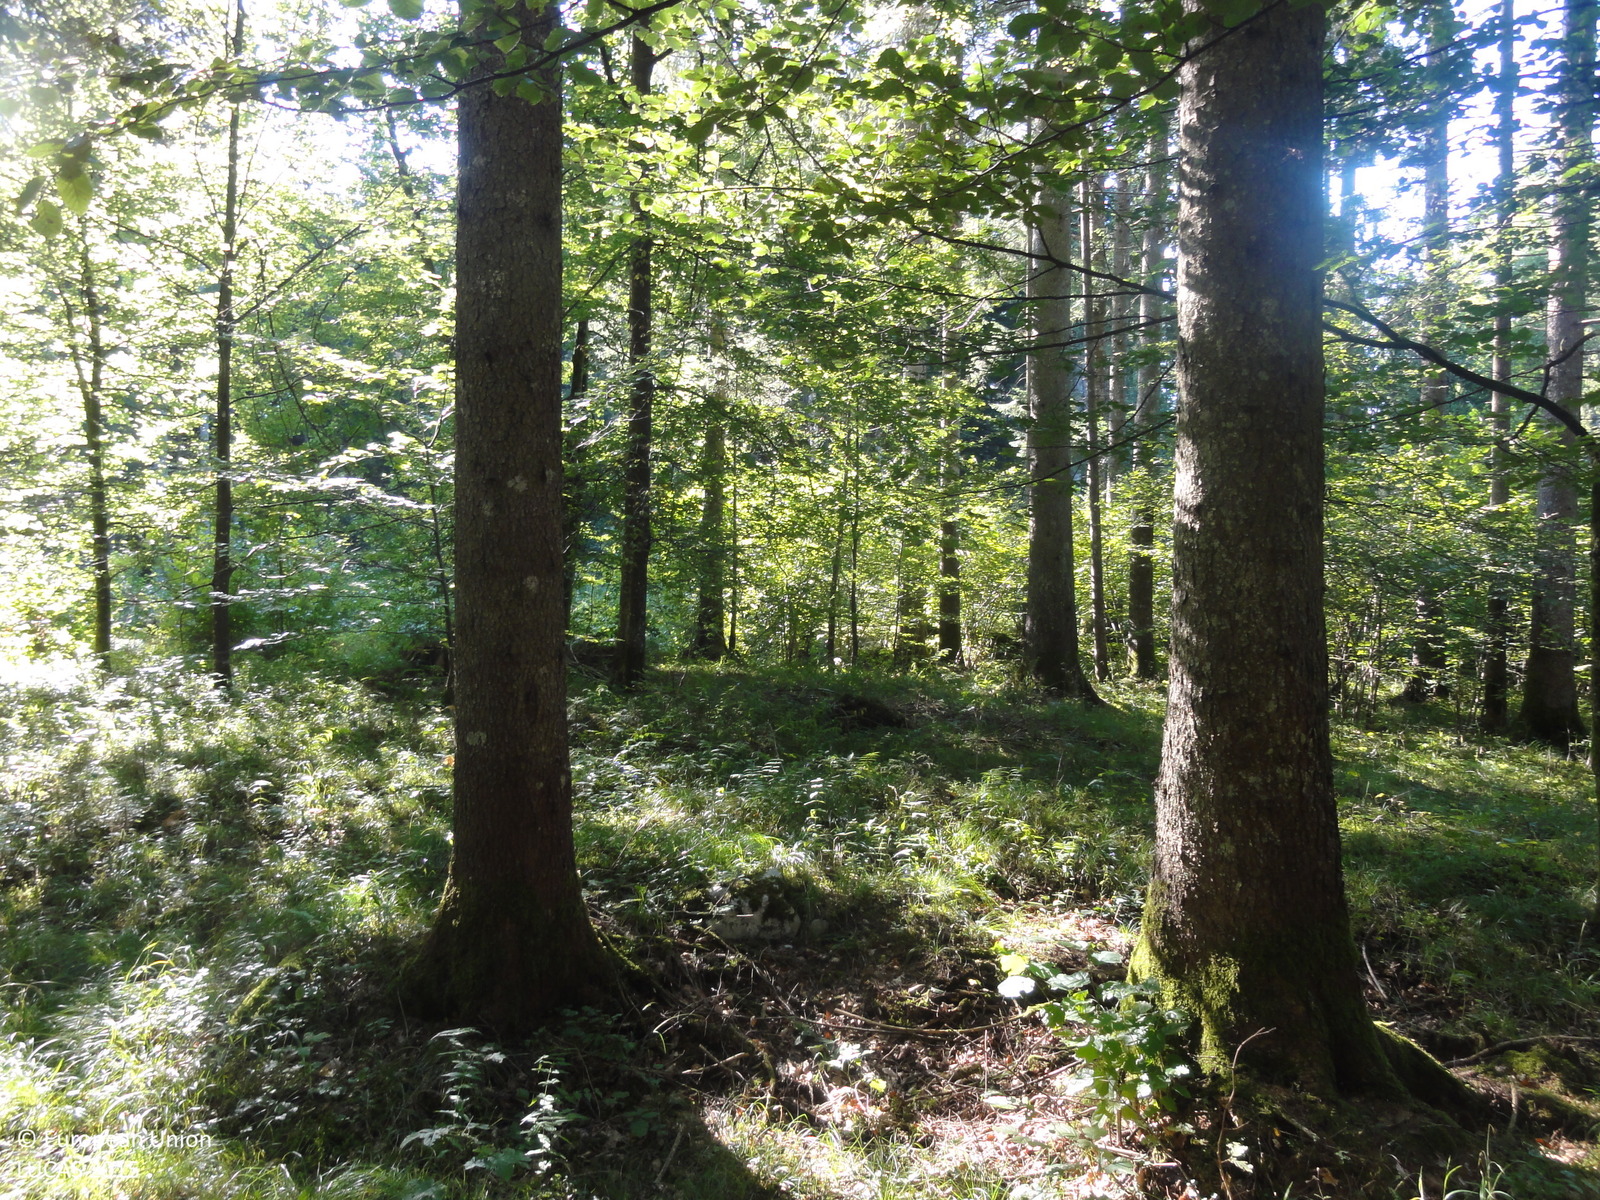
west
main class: Woodland
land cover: Spruce dominated mixed woodland
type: mountainous beech forest
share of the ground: > 75 %
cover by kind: coniferous forest trees 55 %, broadleaved forest trees 30 %, herbaceous plants 10 %, unconsolidated bare surface 5 %
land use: Forestry
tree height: > 5 m
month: September
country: SI
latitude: 45.6836
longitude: 14.8107
